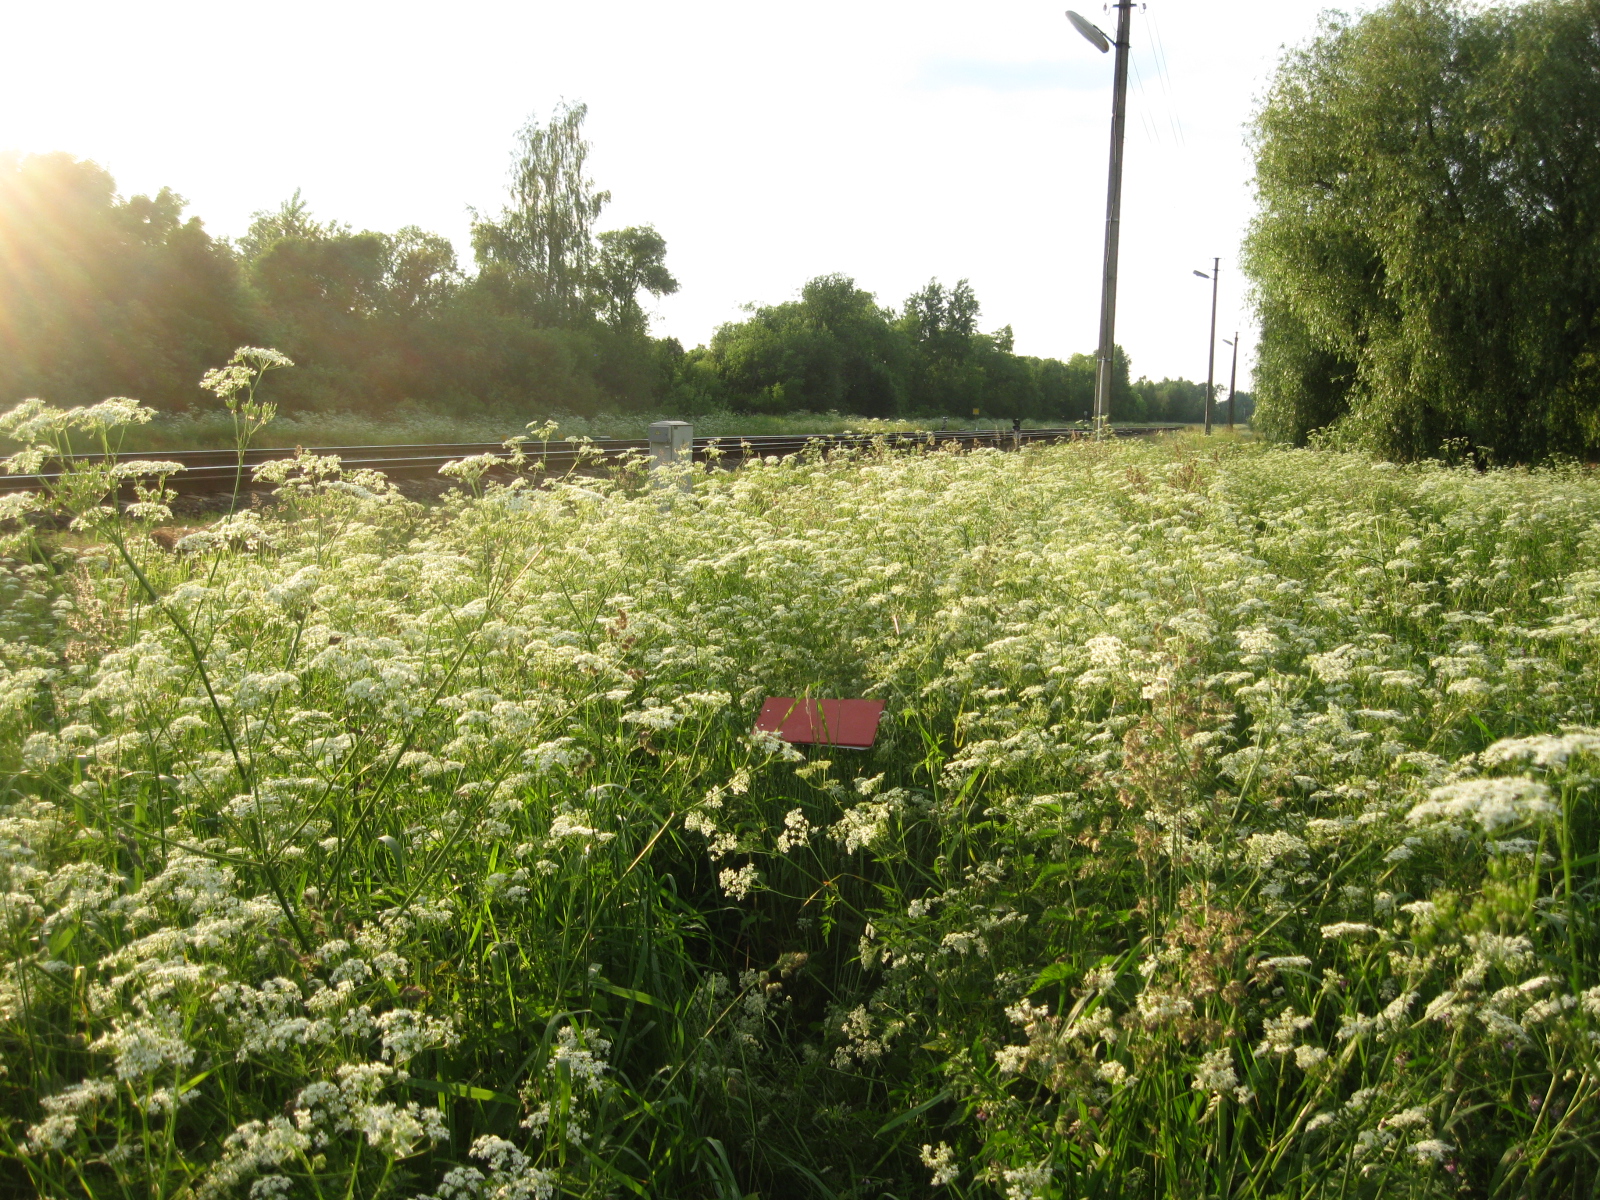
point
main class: Grassland
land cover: Spontaneously vegetated surfaces
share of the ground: > 75 %
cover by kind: herbaceous plants 100 %
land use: Railway transport
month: June
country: LT
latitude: 55.5298
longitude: 23.7886
